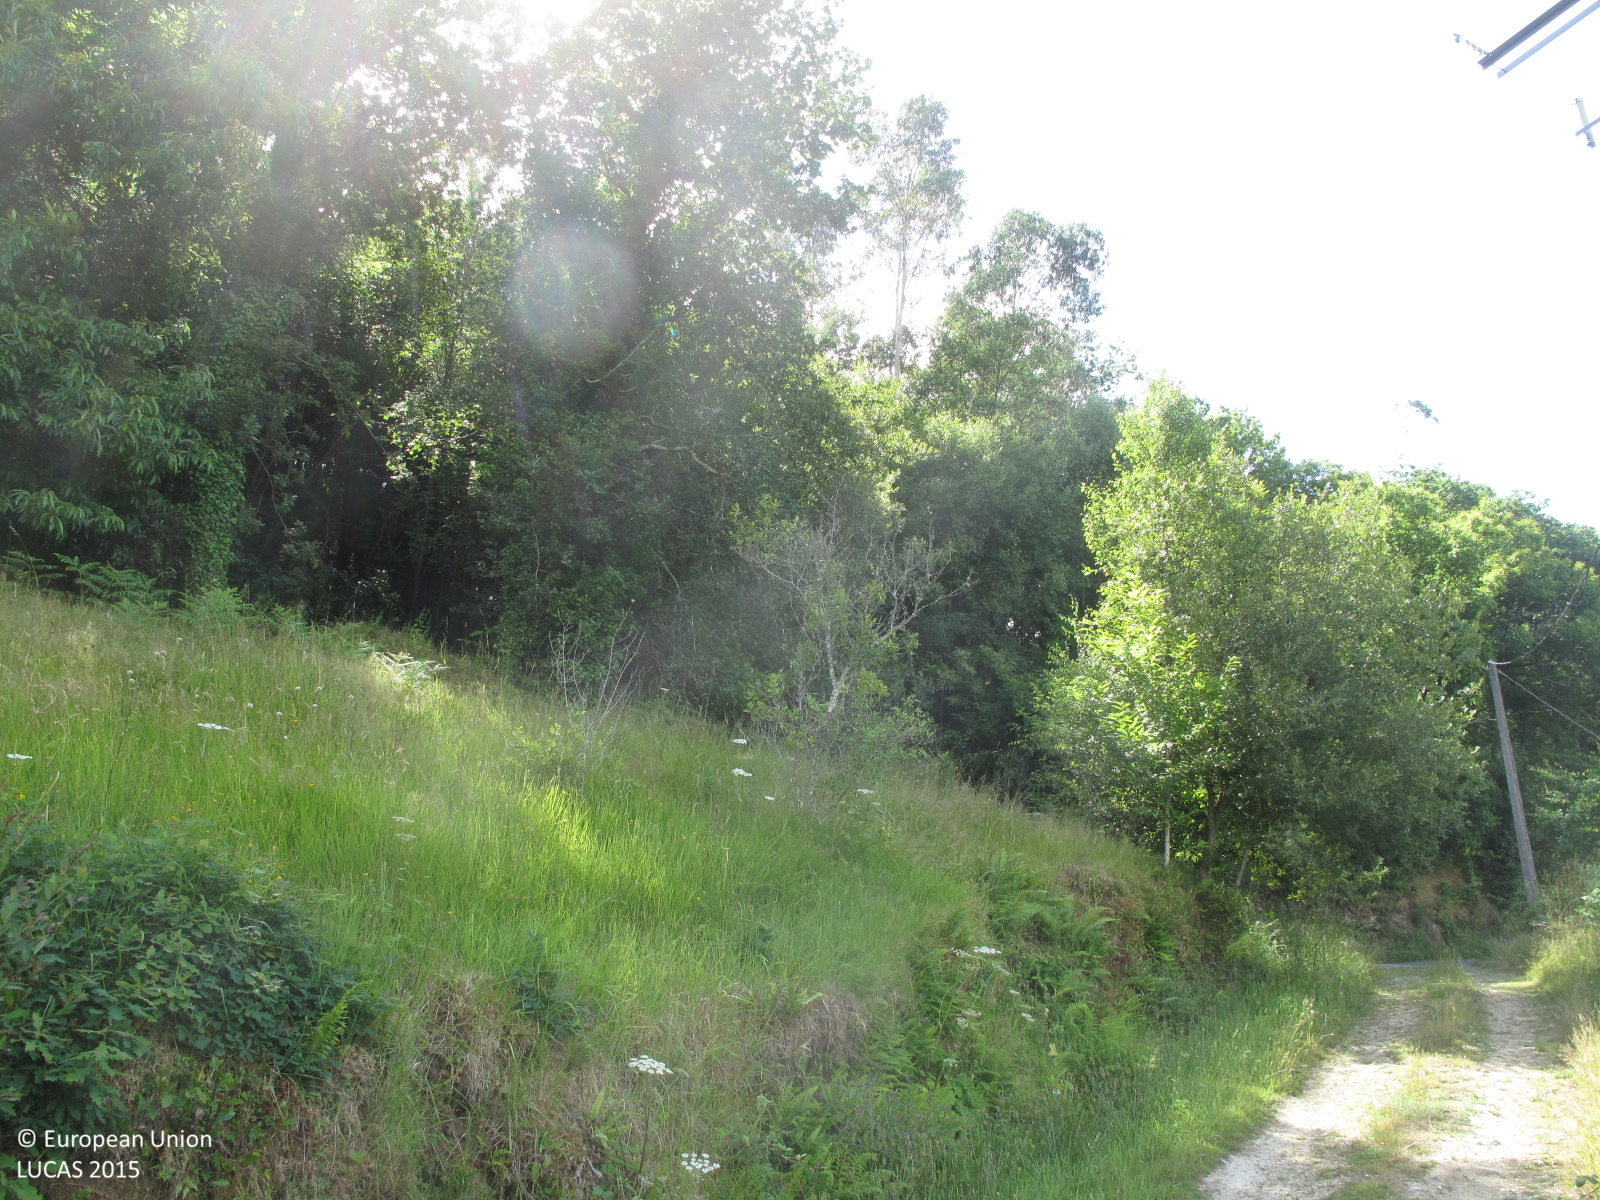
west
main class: Grassland
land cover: Grassland with sparse tree/shrub cover
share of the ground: > 75 %
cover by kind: herbaceous plants 90 %, broadleaved forest trees 5 %, shrubs 5 %
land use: Abandoned areas
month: July
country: ES
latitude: 43.2163
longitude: -8.5371
